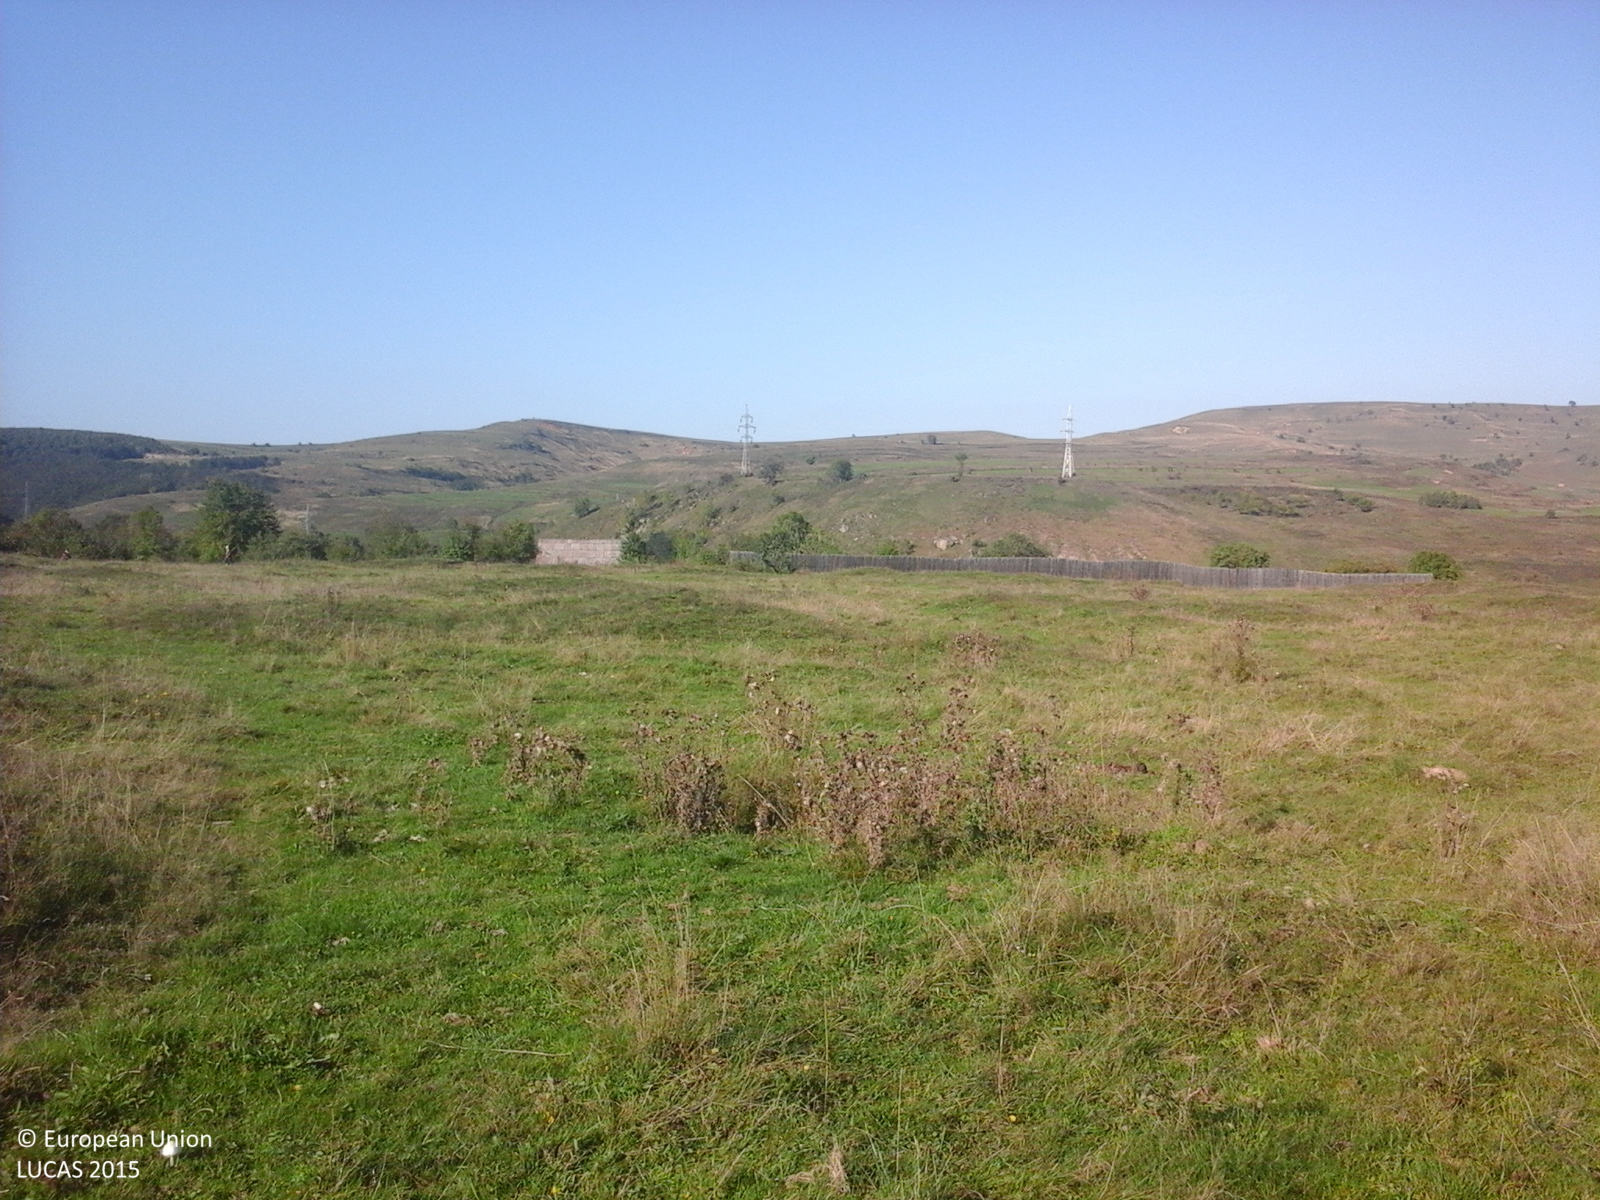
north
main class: Grassland
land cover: Grassland without tree/shrub cover
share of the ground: > 75 %
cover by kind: herbaceous plants 100 %
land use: Agriculture (excluding fallow land and kitchen gardens)
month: October
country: RO
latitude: 46.5716
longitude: 23.4672
